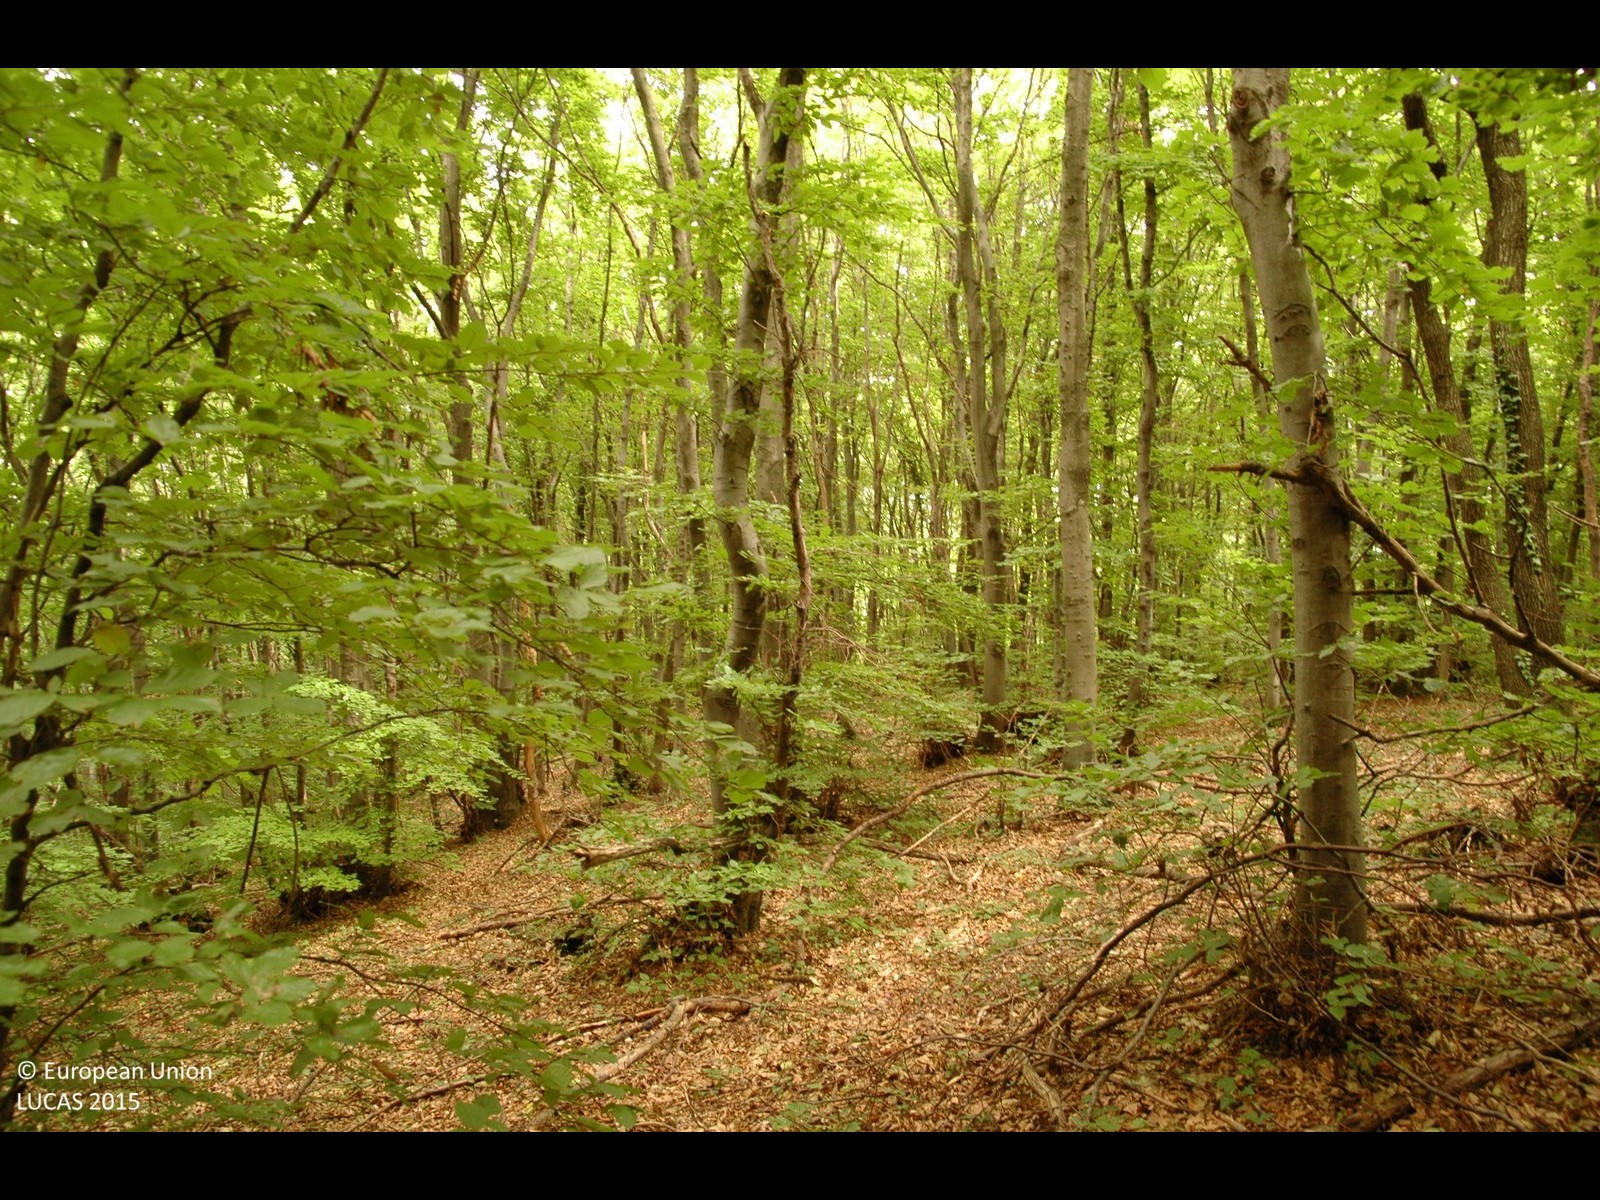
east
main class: Woodland
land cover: Broadleaved woodland
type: mesophytic deciduous forest
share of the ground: > 75 %
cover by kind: broadleaved forest trees 100 %
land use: Forestry
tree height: > 5 m
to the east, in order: Broadleaved woodland
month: August
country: HR
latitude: 45.8884
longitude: 16.0937
